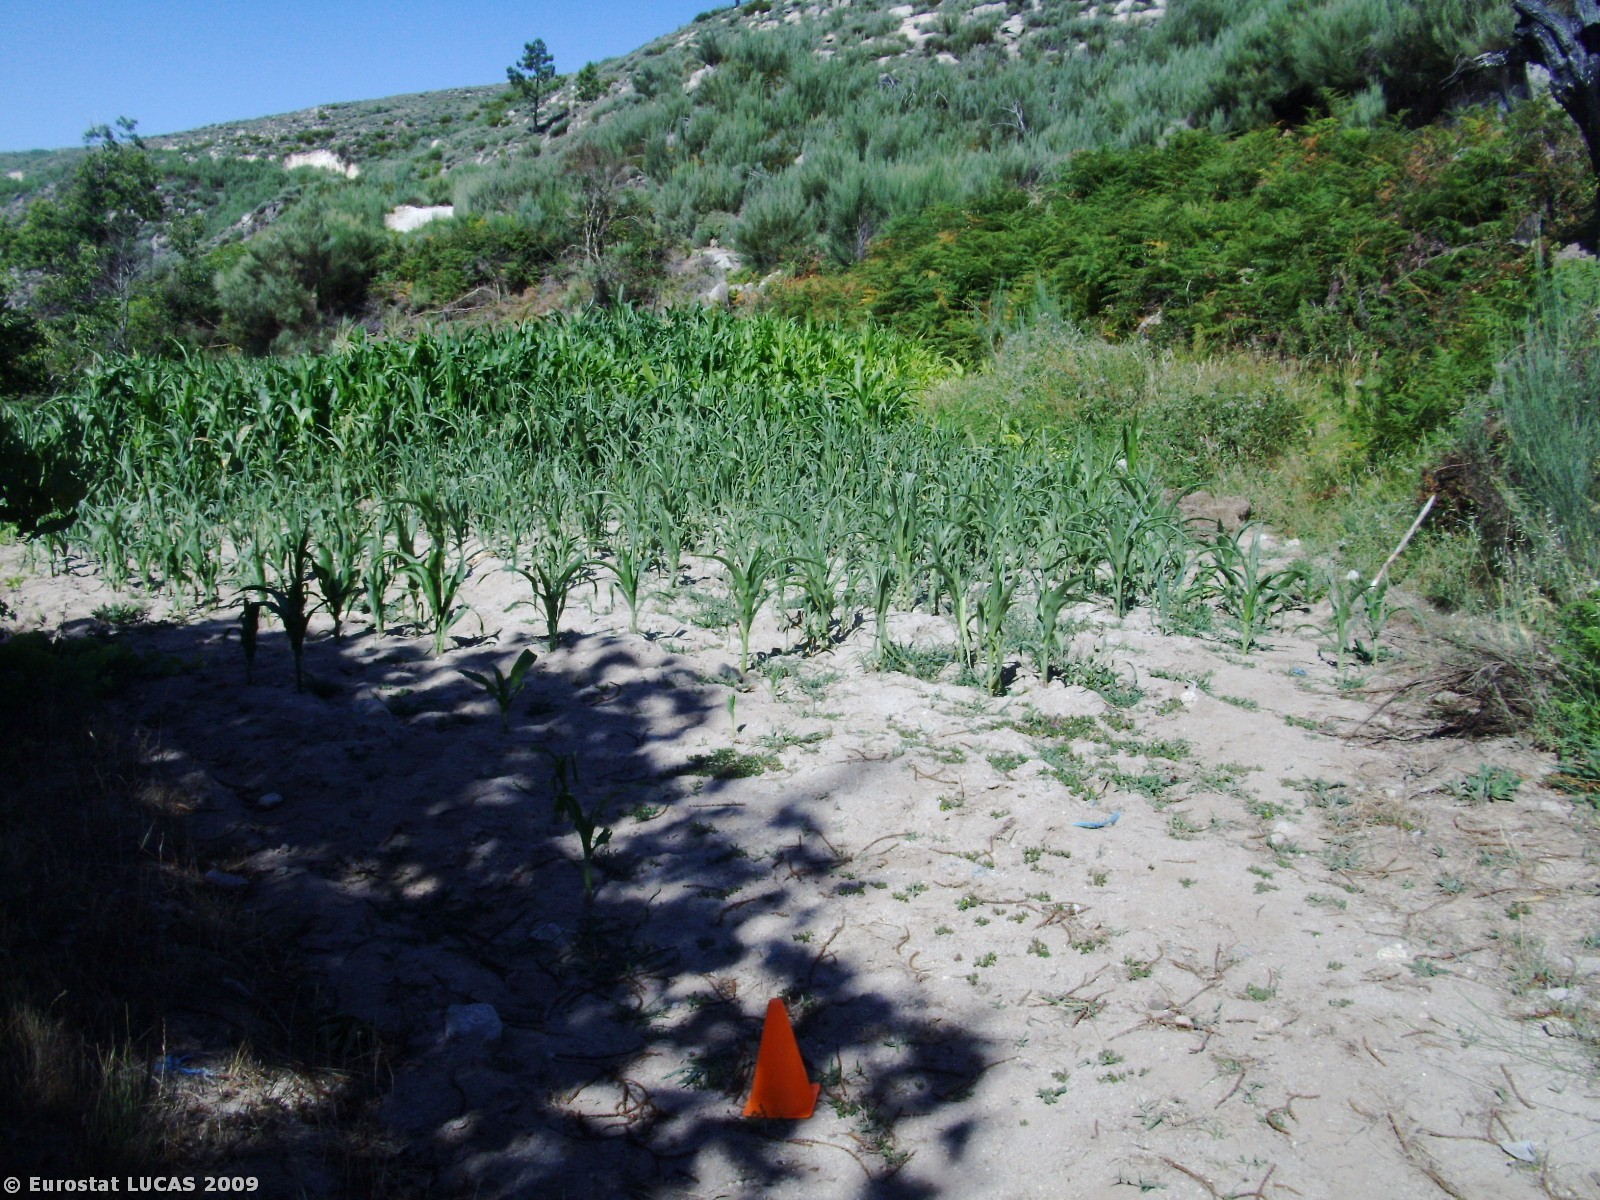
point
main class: Cropland
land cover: Maize
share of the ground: > 75 %
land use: Agriculture (excluding fallow land and kitchen gardens)
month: July
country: PT
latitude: 40.4850
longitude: -7.3183
